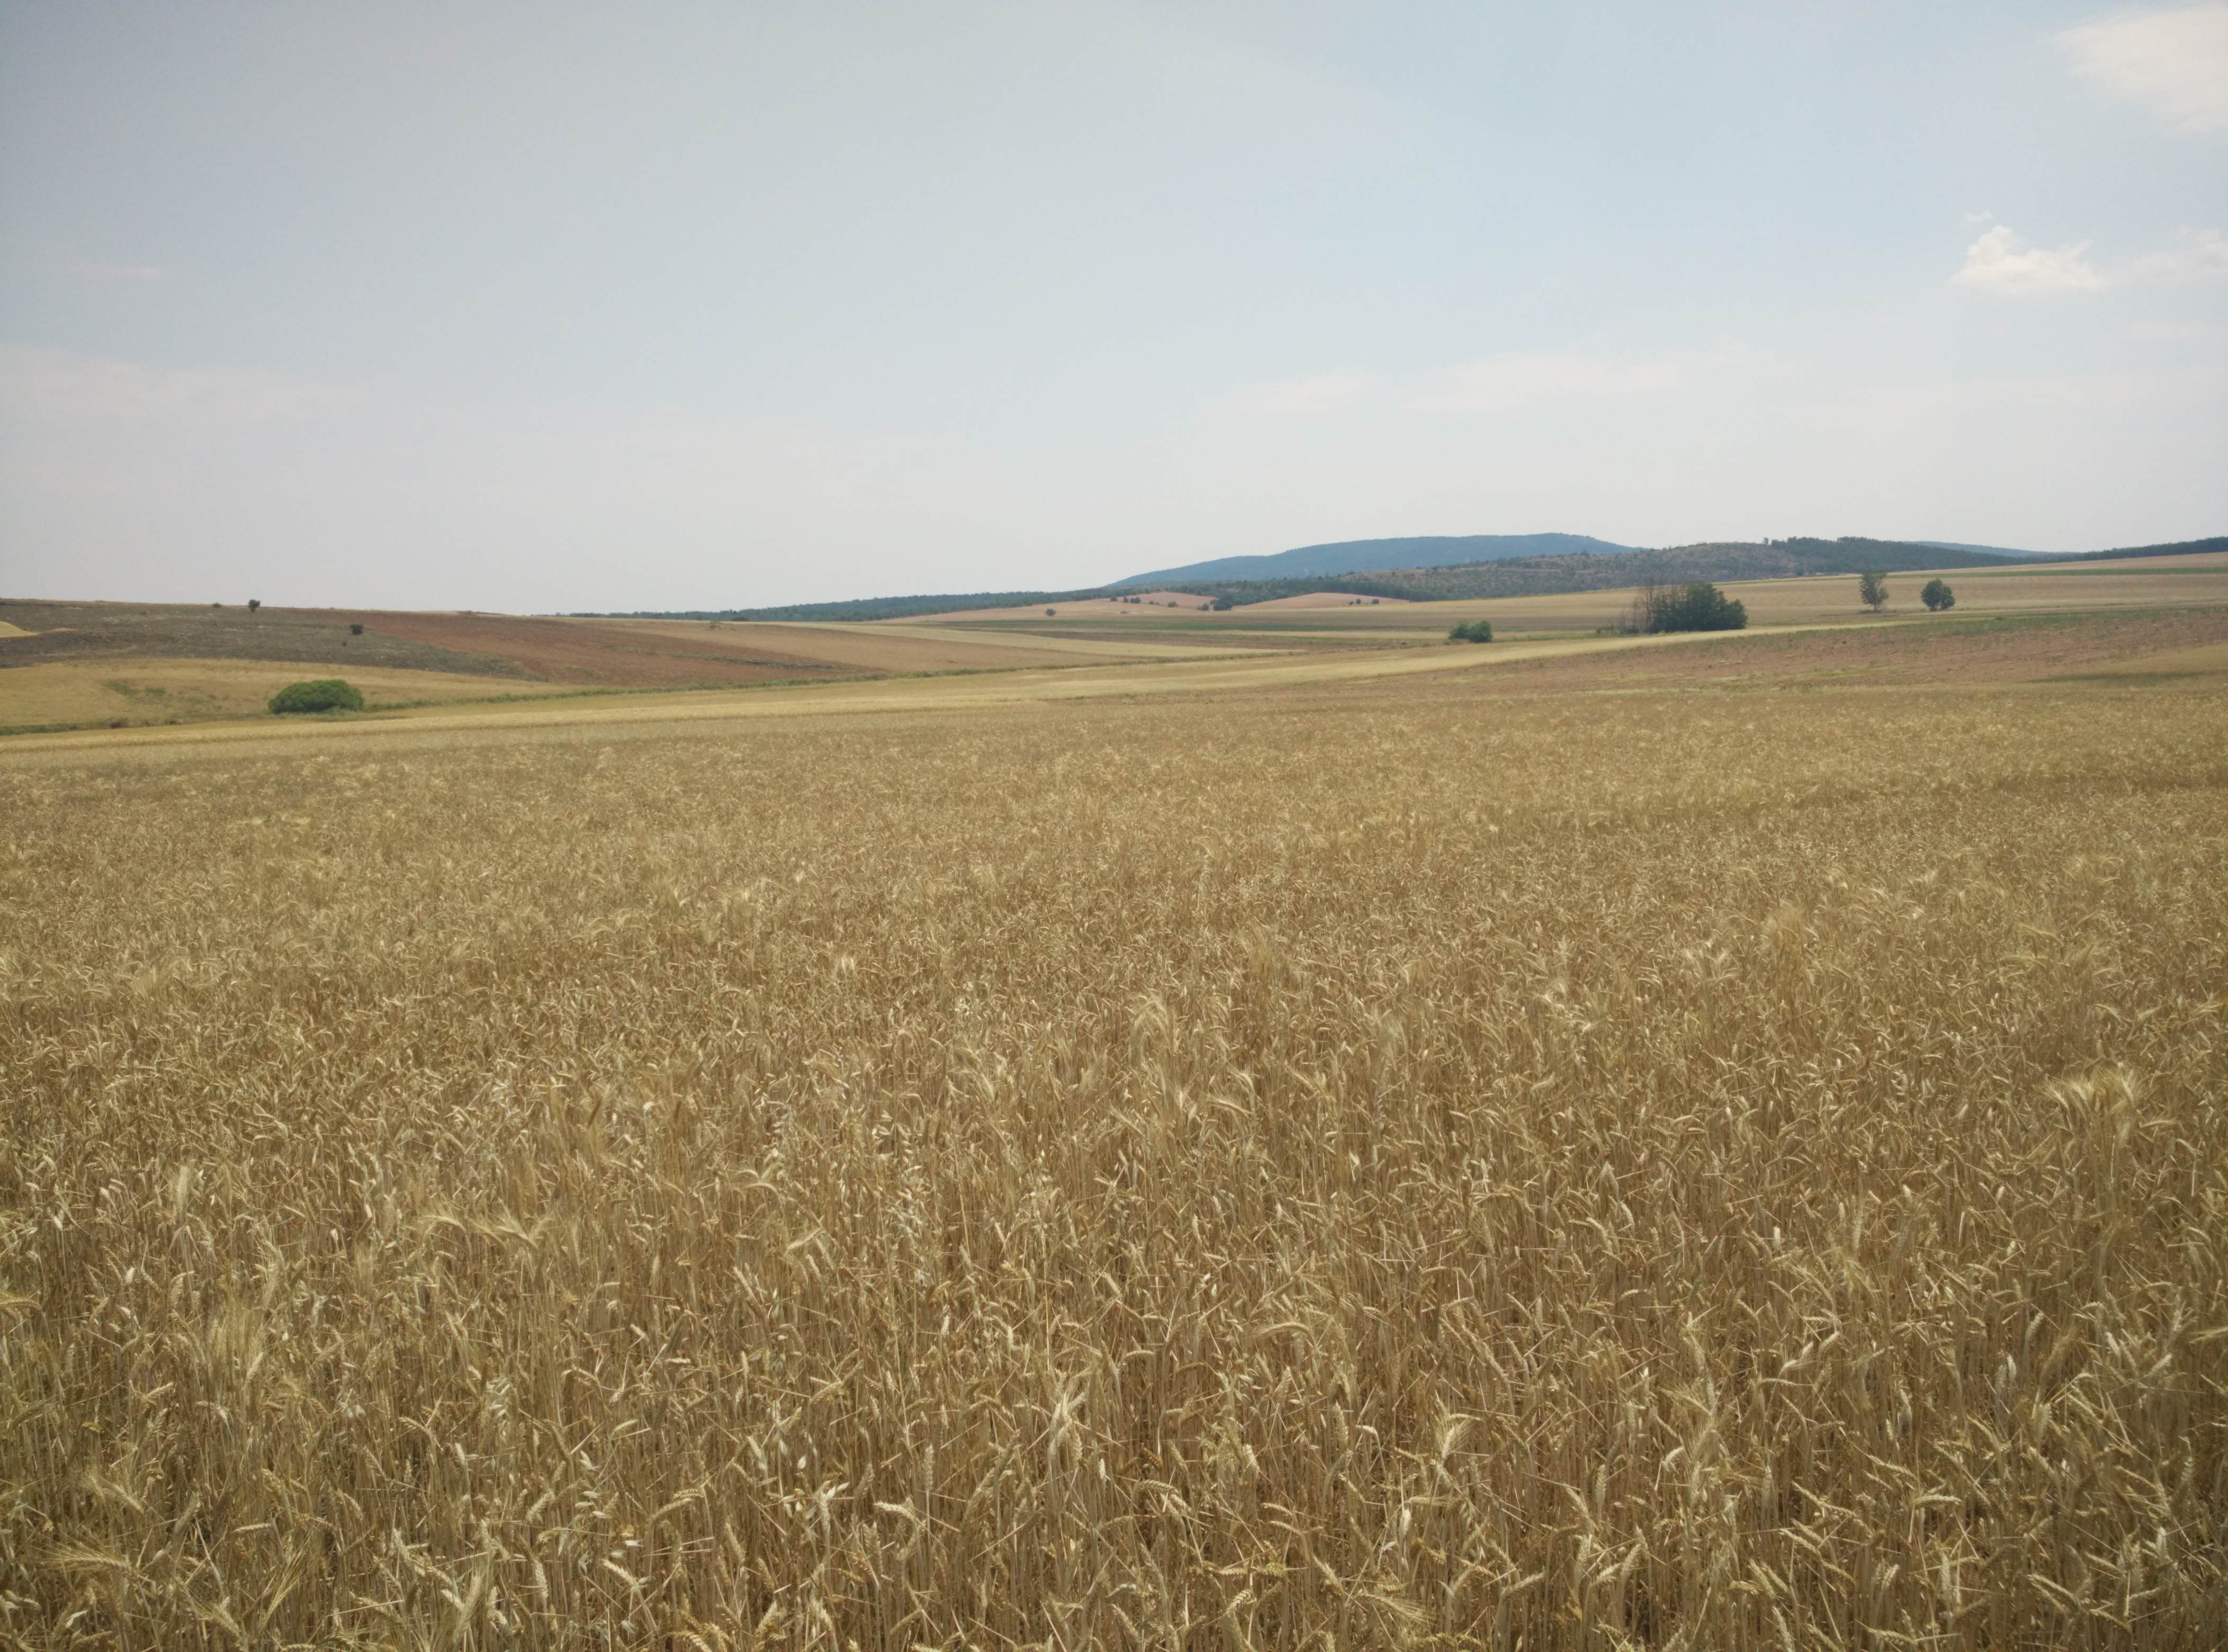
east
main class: Cropland
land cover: Common wheat
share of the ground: > 75 %
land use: Agriculture (excluding fallow land and kitchen gardens)
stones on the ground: 25 - 50 %
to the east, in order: Common wheat; Grass margins; Sunflower; Grass margins; Durum wheat; Grass margins; Ditches and canals; Grass margins; Common wheat
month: June
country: ES
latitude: 40.8790
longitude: -1.8535
